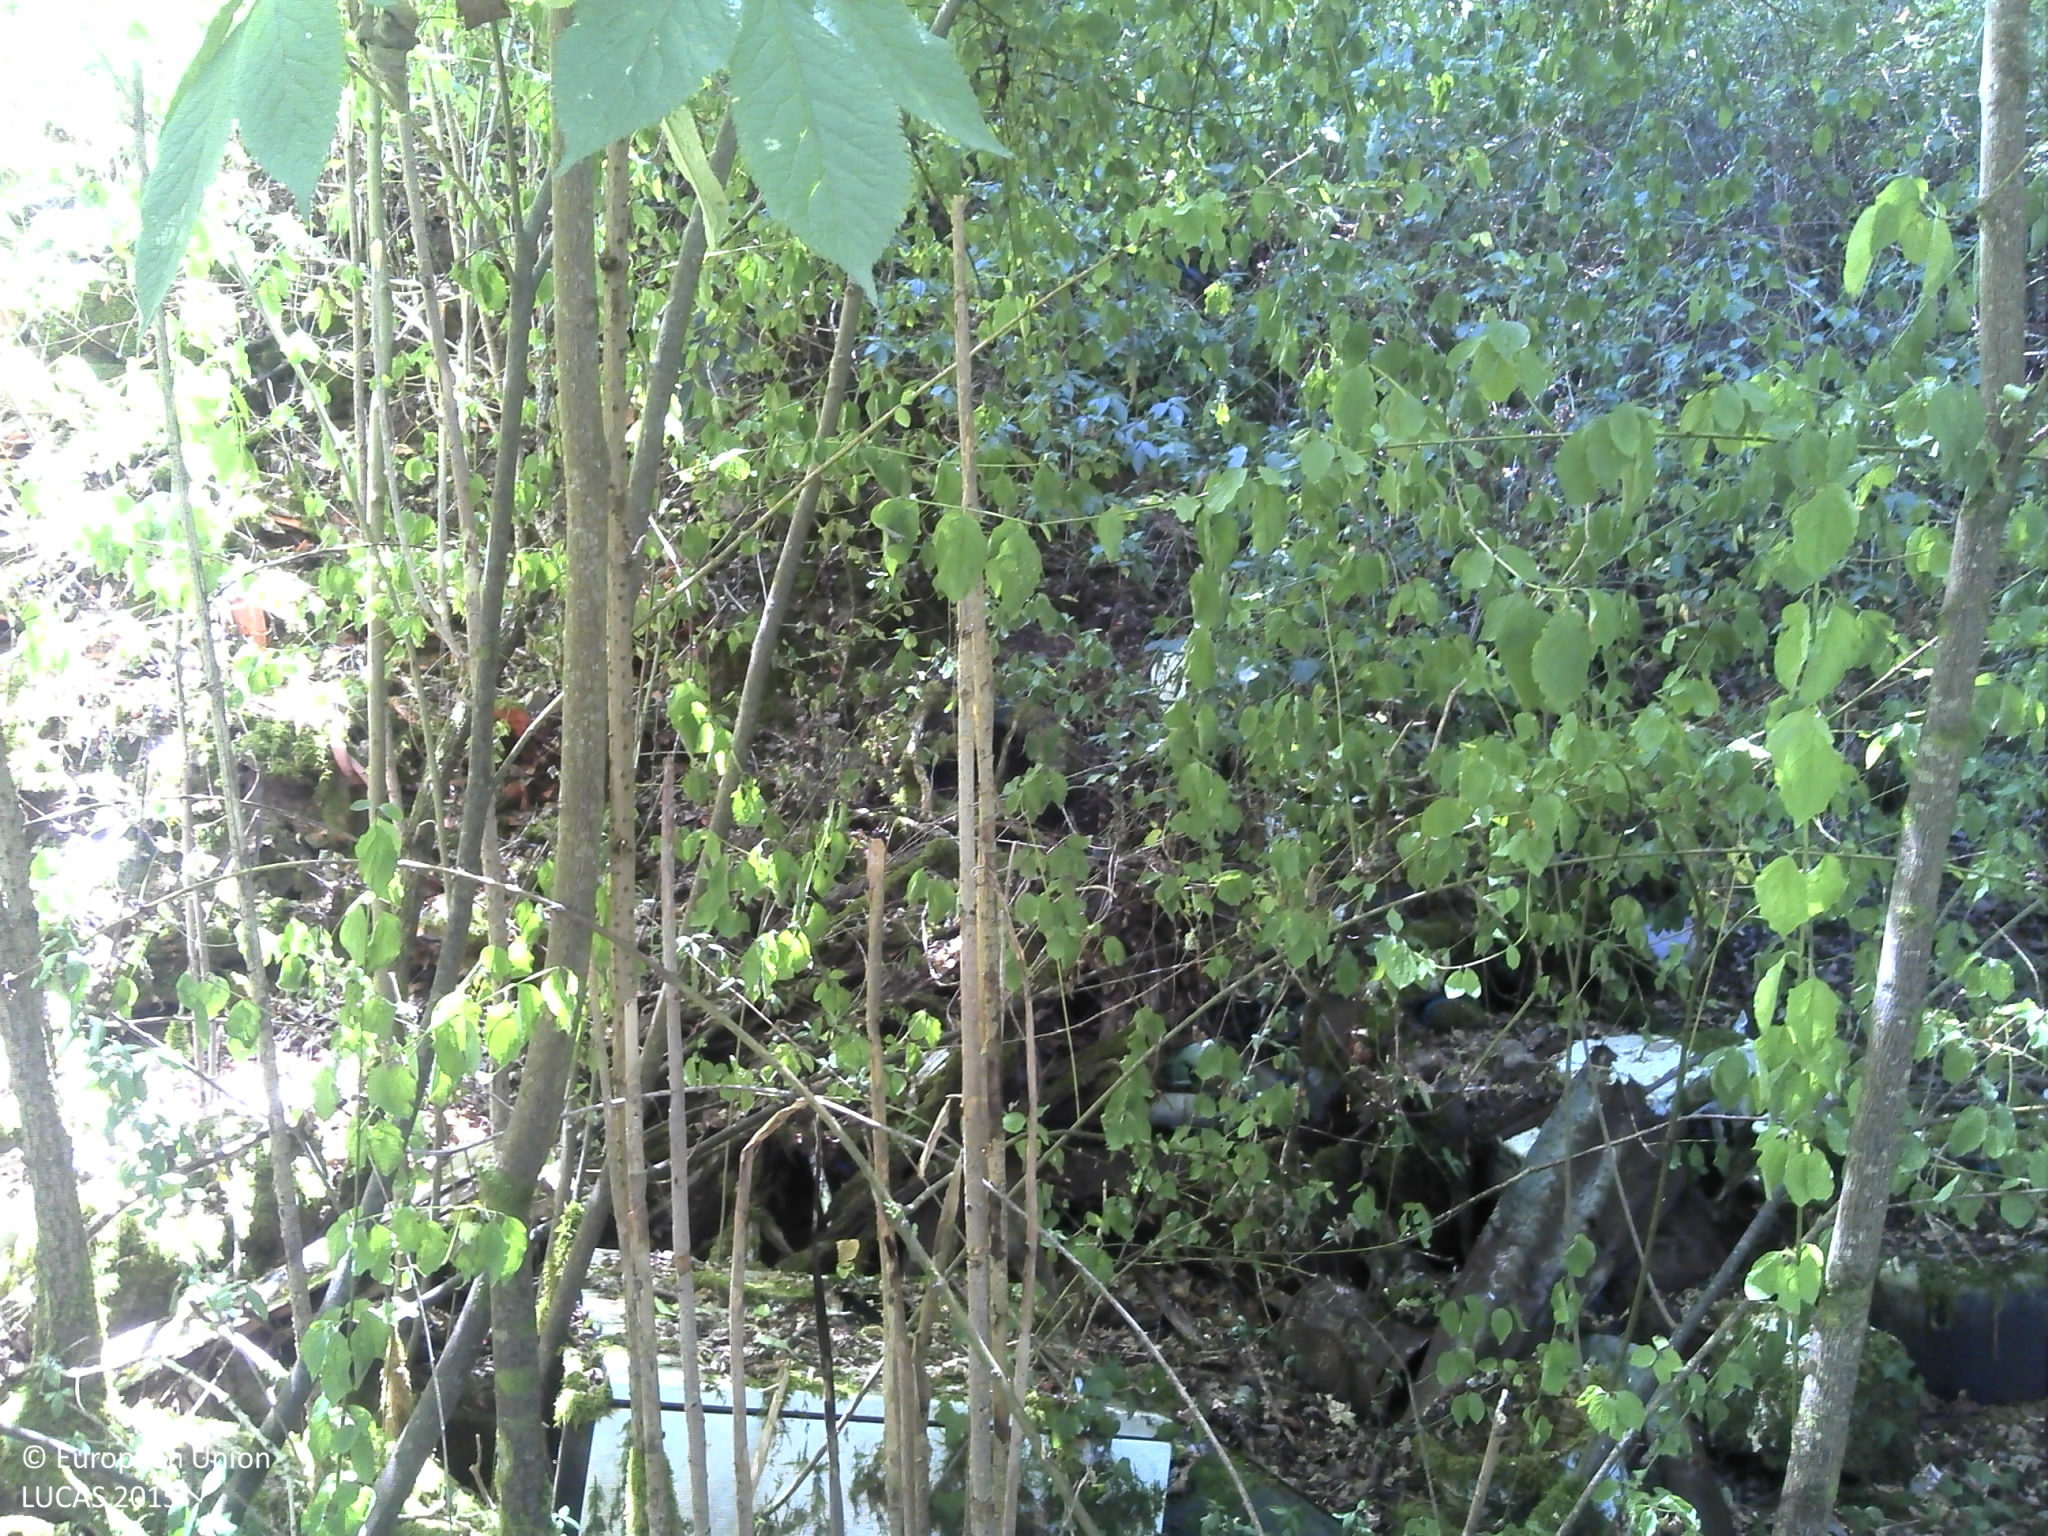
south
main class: Woodland
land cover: Broadleaved woodland
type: thermophilous deciduous forest
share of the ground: > 75 %
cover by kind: broadleaved forest trees 65 %, herbaceous plants 20 %, unconsolidated bare surface 5 %
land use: Abandoned areas
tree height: > 5 m
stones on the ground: < 10 %
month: July
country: FR
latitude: 45.0528
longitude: 1.7307
